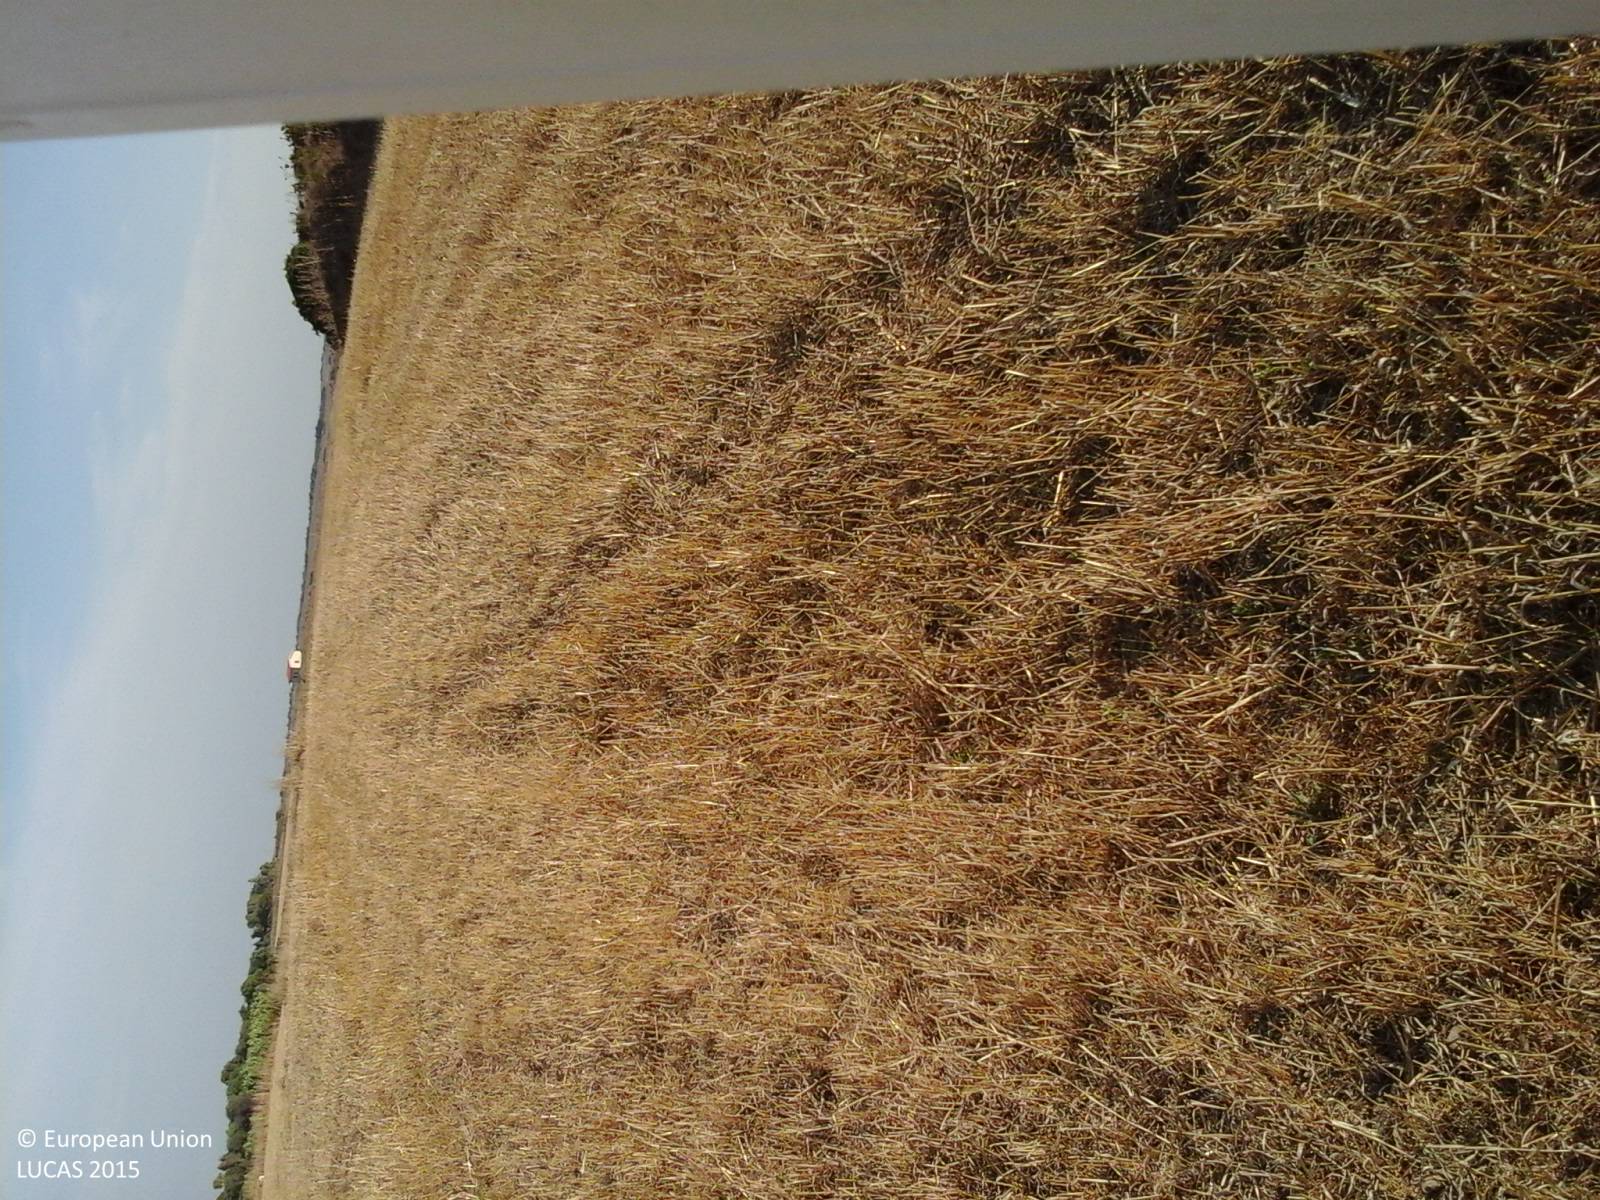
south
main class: Cropland
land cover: Barley
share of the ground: < 10 %
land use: Agriculture (excluding fallow land and kitchen gardens)
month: August
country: IT
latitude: 40.0197
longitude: 8.4501
